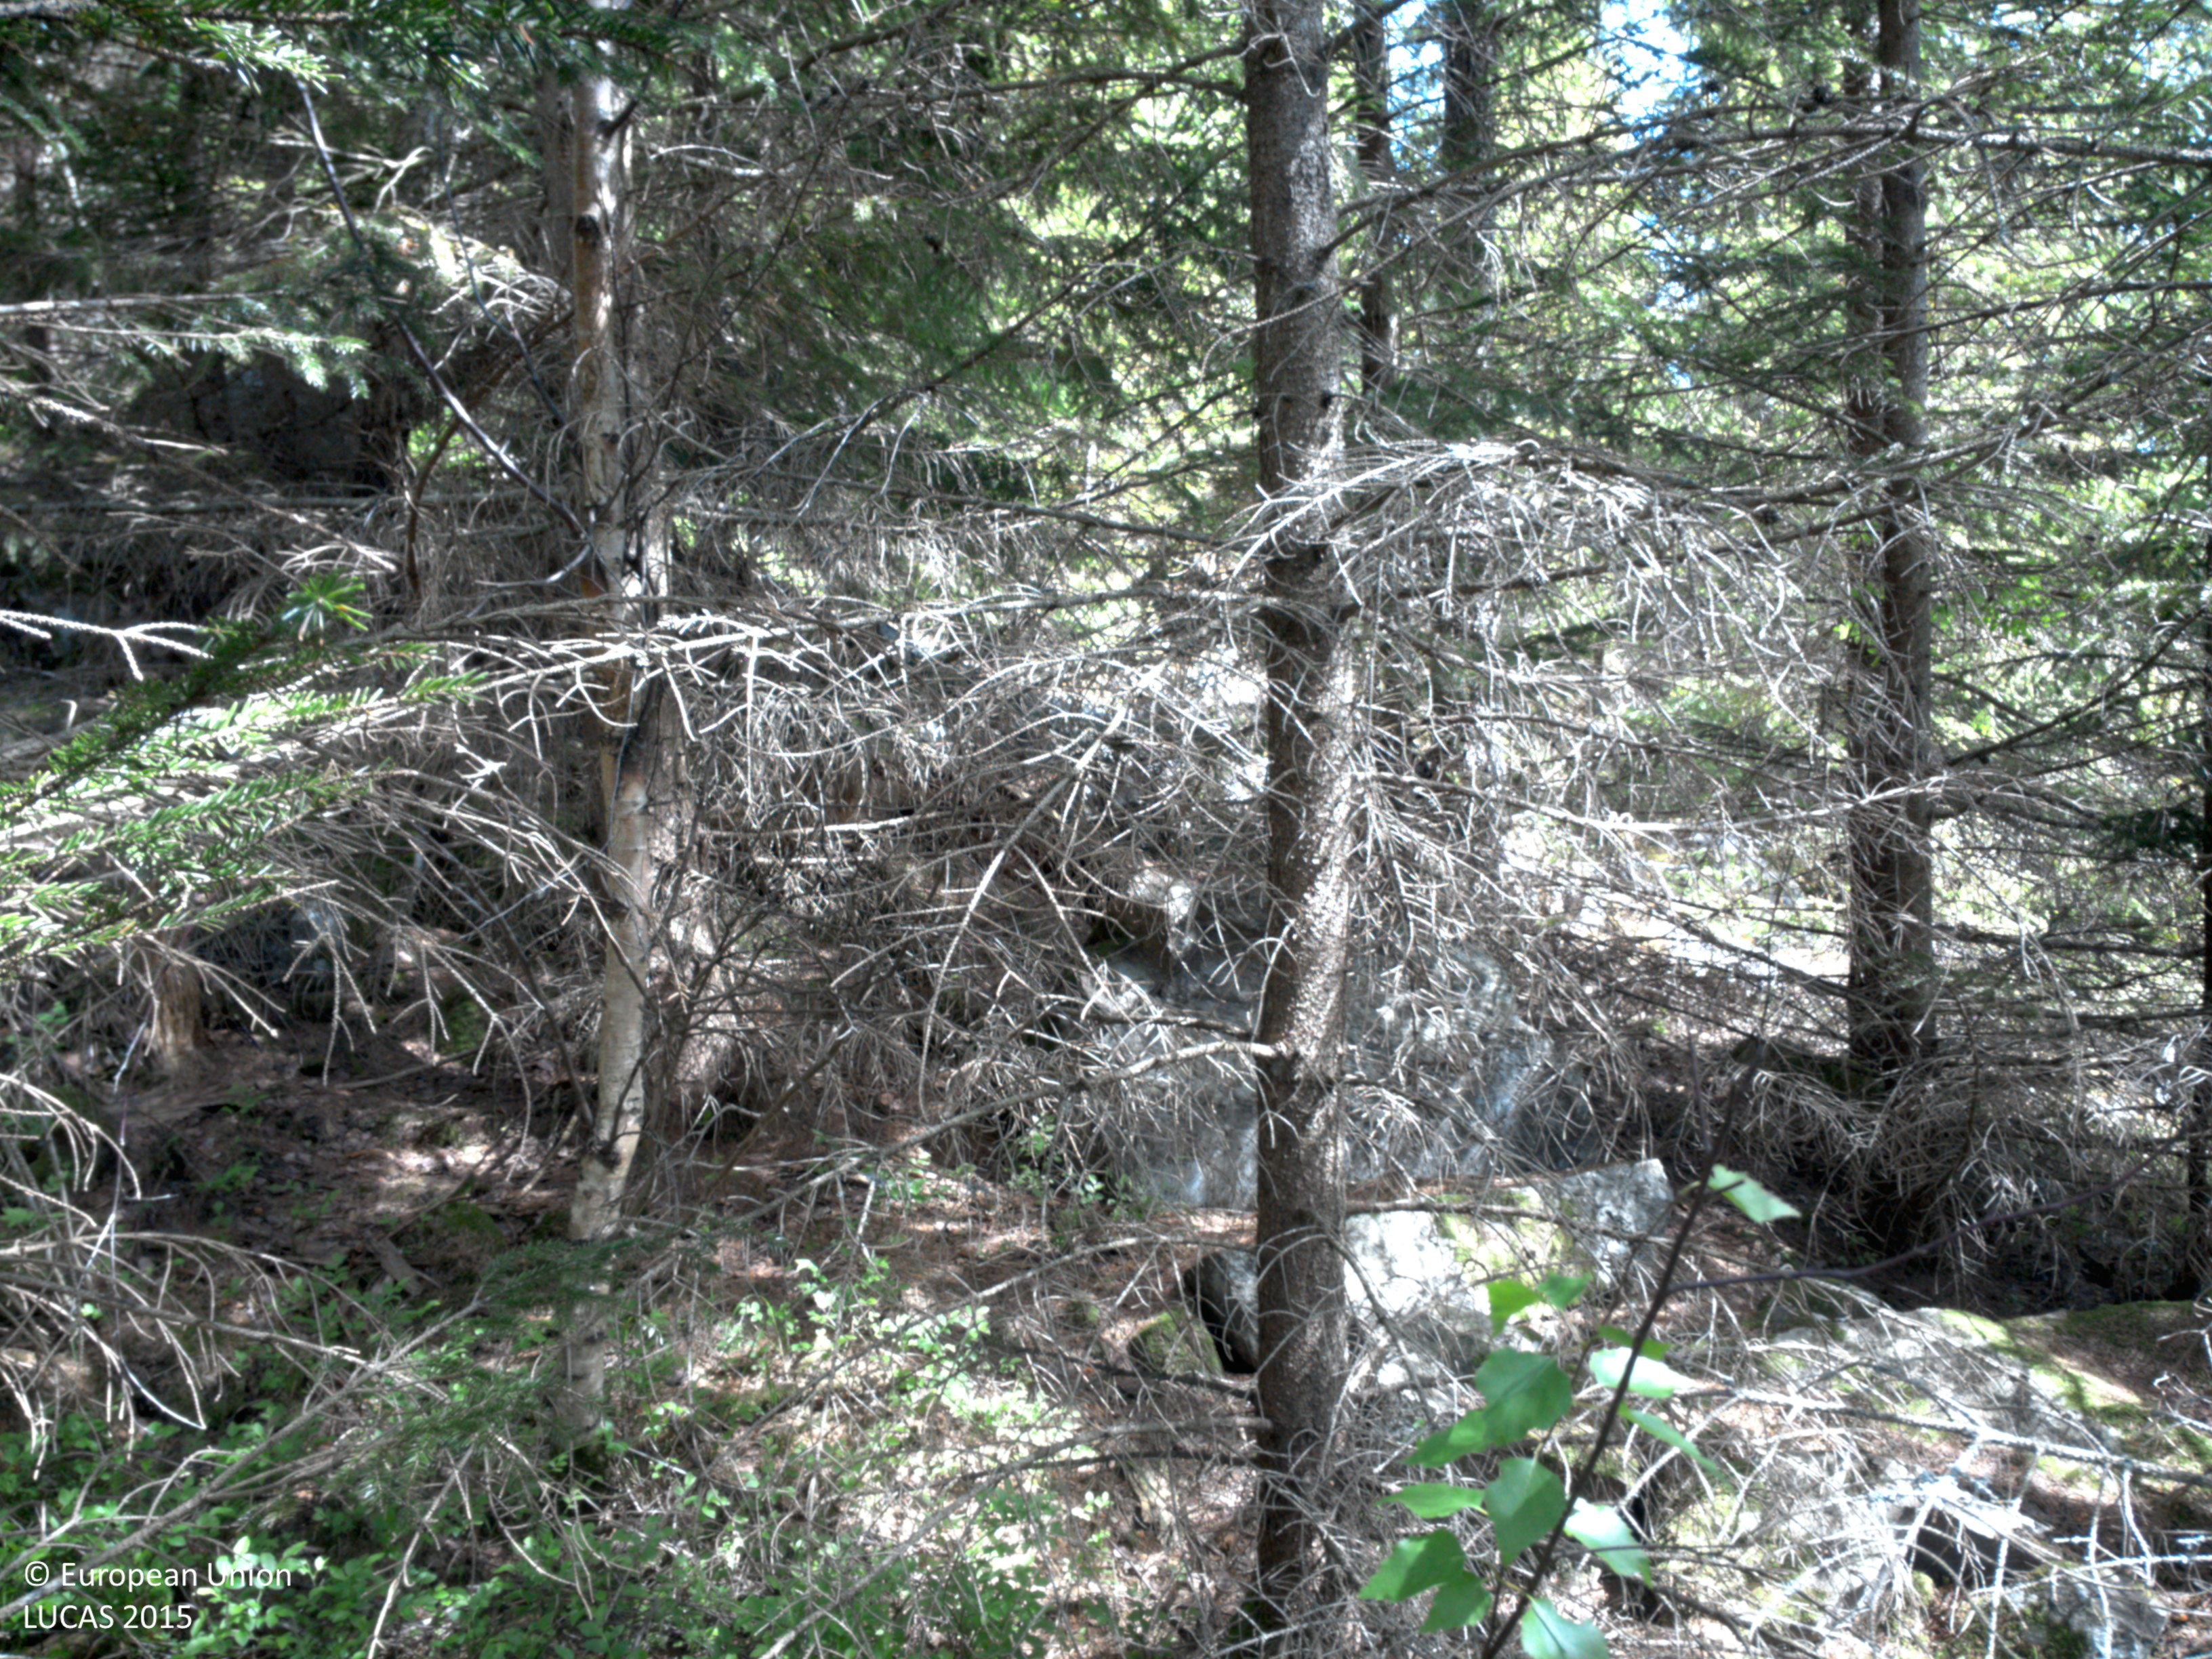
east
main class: Woodland
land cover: Spruce dominated mixed woodland
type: boreal forest
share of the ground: > 75 %
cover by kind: coniferous forest trees 55 %, broadleaved forest trees 25 %, lichens and mosses 15 %, shrubs 5 %
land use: Forestry
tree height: > 5 m
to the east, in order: Spruce dominated mixed woodland; Rivers and streams; Spruce dominated coniferous woodland; Spruce dominated mixed woodland
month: June
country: SE
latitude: 59.0802
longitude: 12.3848
